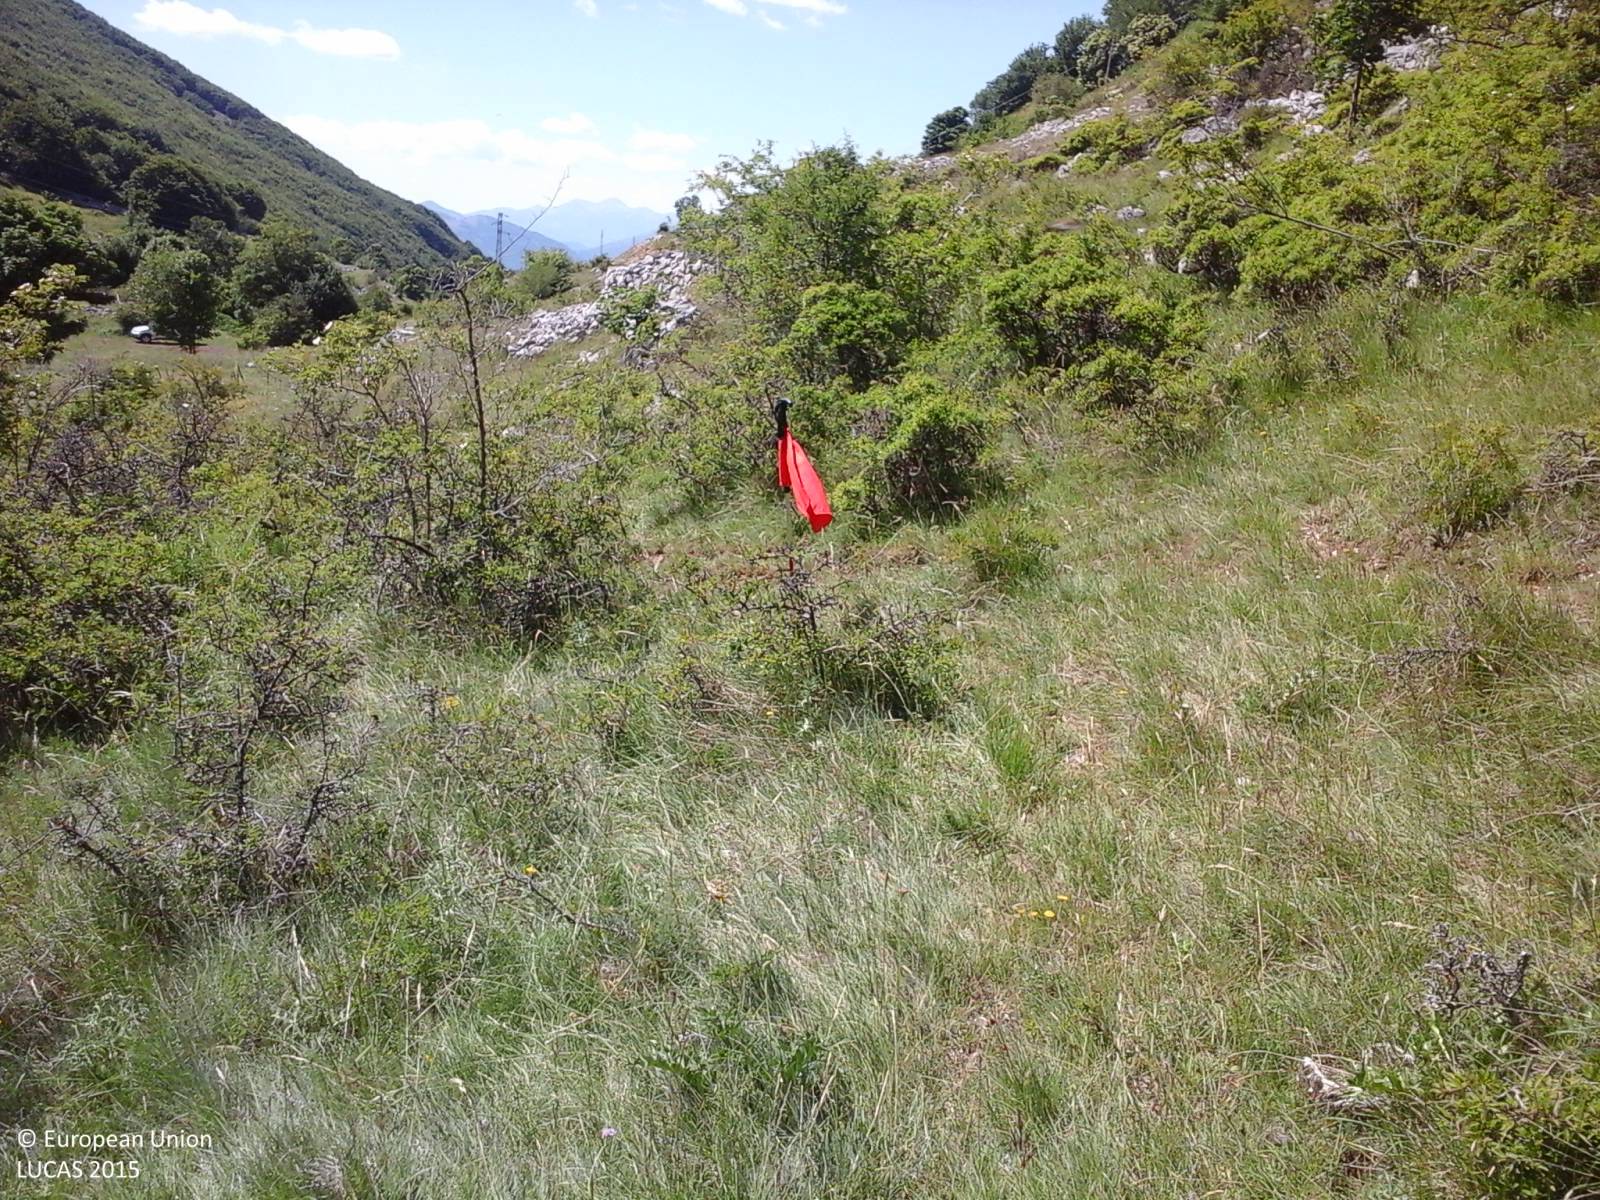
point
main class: Shrubland
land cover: Shrubland with sparse tree cover
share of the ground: > 75 %
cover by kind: herbaceous plants 50 %, shrubs 40 %, broadleaved forest trees 5 %, unconsolidated bare surface 5 %
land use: Agriculture (excluding fallow land and kitchen gardens)
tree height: < 5 m
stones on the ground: 10 - 25 %
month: June
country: IT
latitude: 42.2537
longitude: 13.3948
